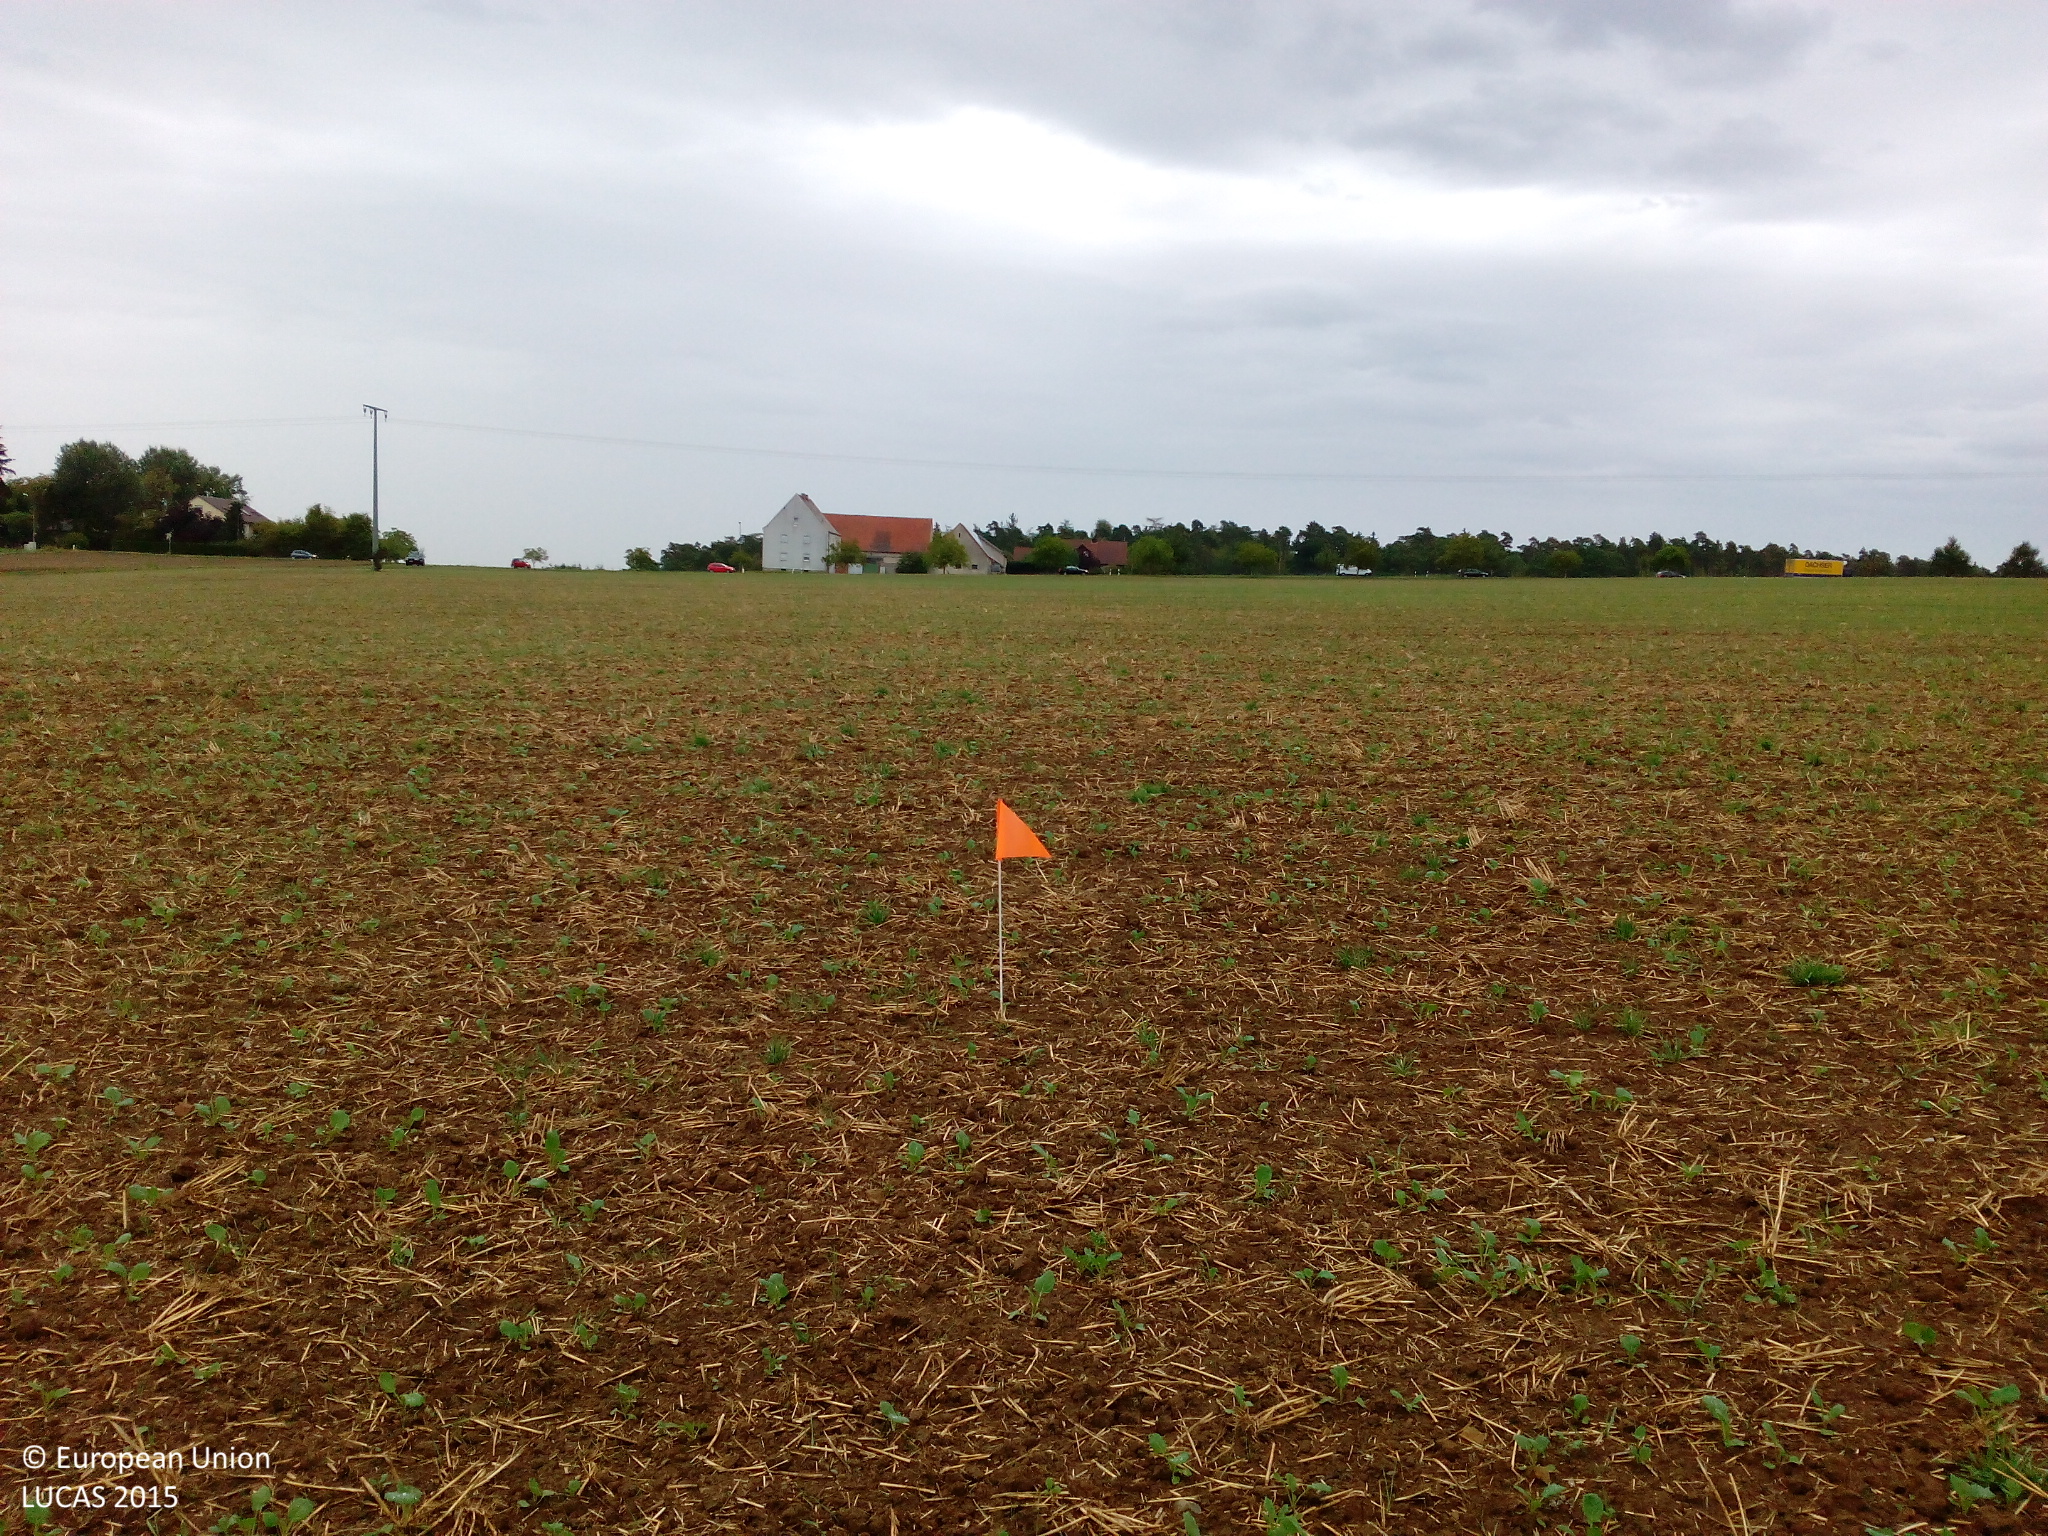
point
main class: Cropland
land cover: Common wheat
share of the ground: 10 - 25 %
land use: Agriculture (excluding fallow land and kitchen gardens)
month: September
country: DE
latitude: 49.8425
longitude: 9.9027
